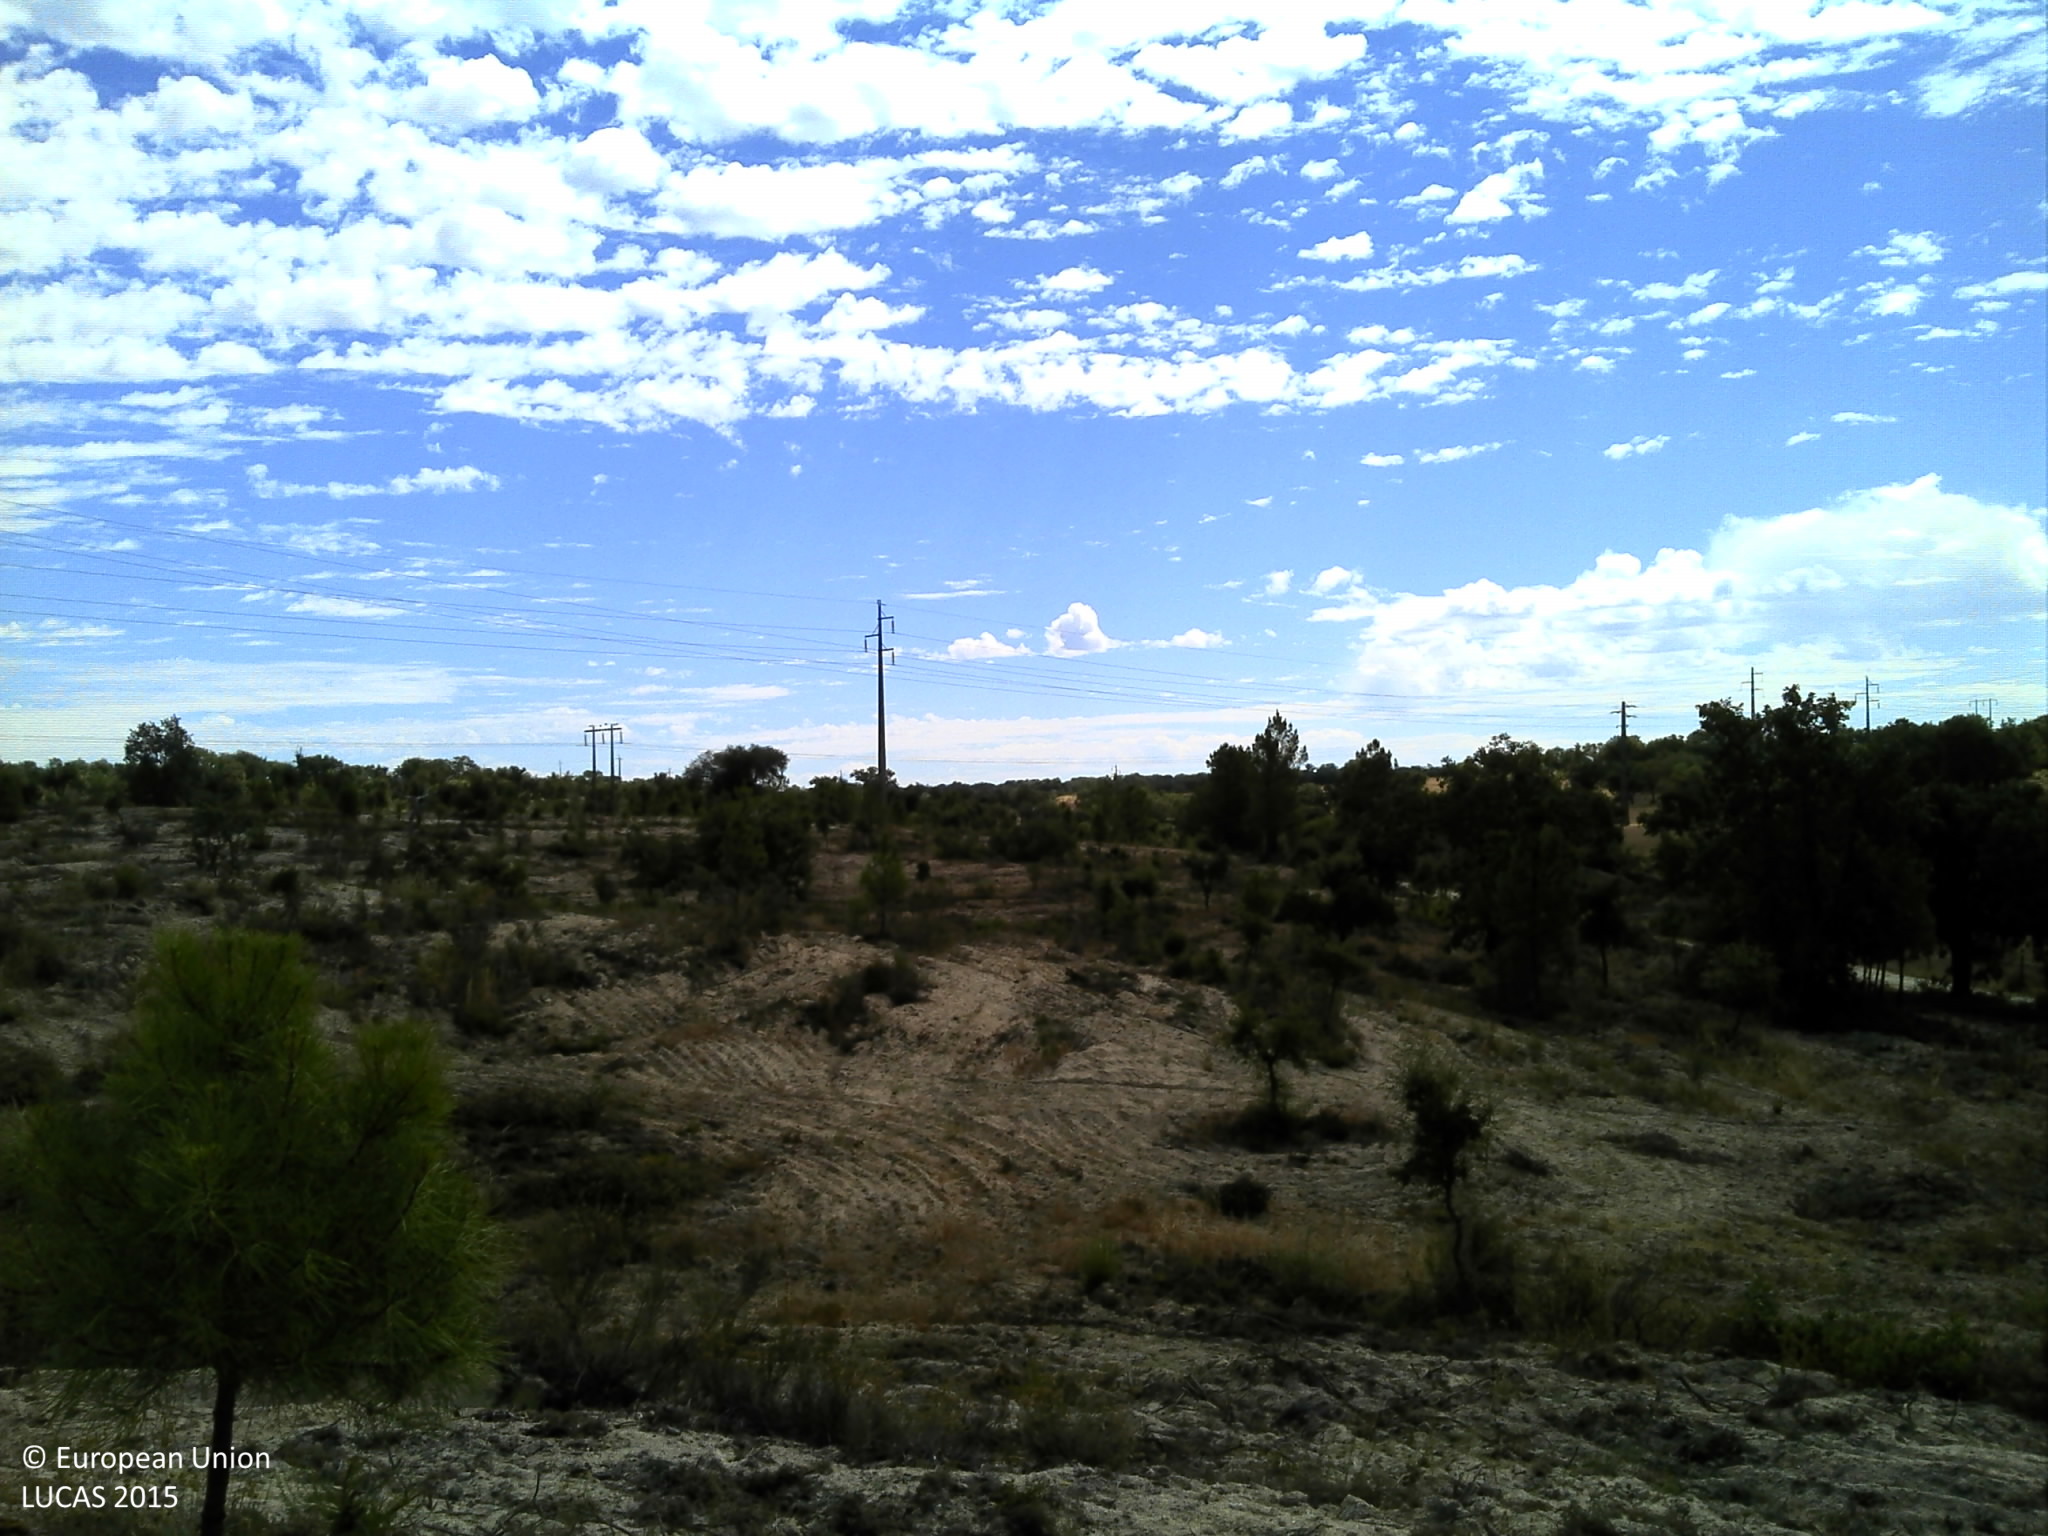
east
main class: Woodland
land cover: Broadleaved woodland
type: broadleaved evergreen forest
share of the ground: 10 - 25 %
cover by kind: unconsolidated bare surface 90 %, broadleaved forest trees 10 %
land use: Forestry
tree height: < 5 m
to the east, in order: Broadleaved woodland; Other bare soil; Broadleaved woodland; Rivers and streams; Grassland with sparse tree/shrub cover; Broadleaved woodland; Tracks; Broadleaved woodland; Electric lines; Broadleaved woodland; Electric lines; Broadleaved woodland; Pine dominated mixed woodland; Rivers and streams; Pine dominated mixed woodland; Electric lines; Pine dominated mixed woodland
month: August
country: PT
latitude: 39.4905
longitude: -7.7138
